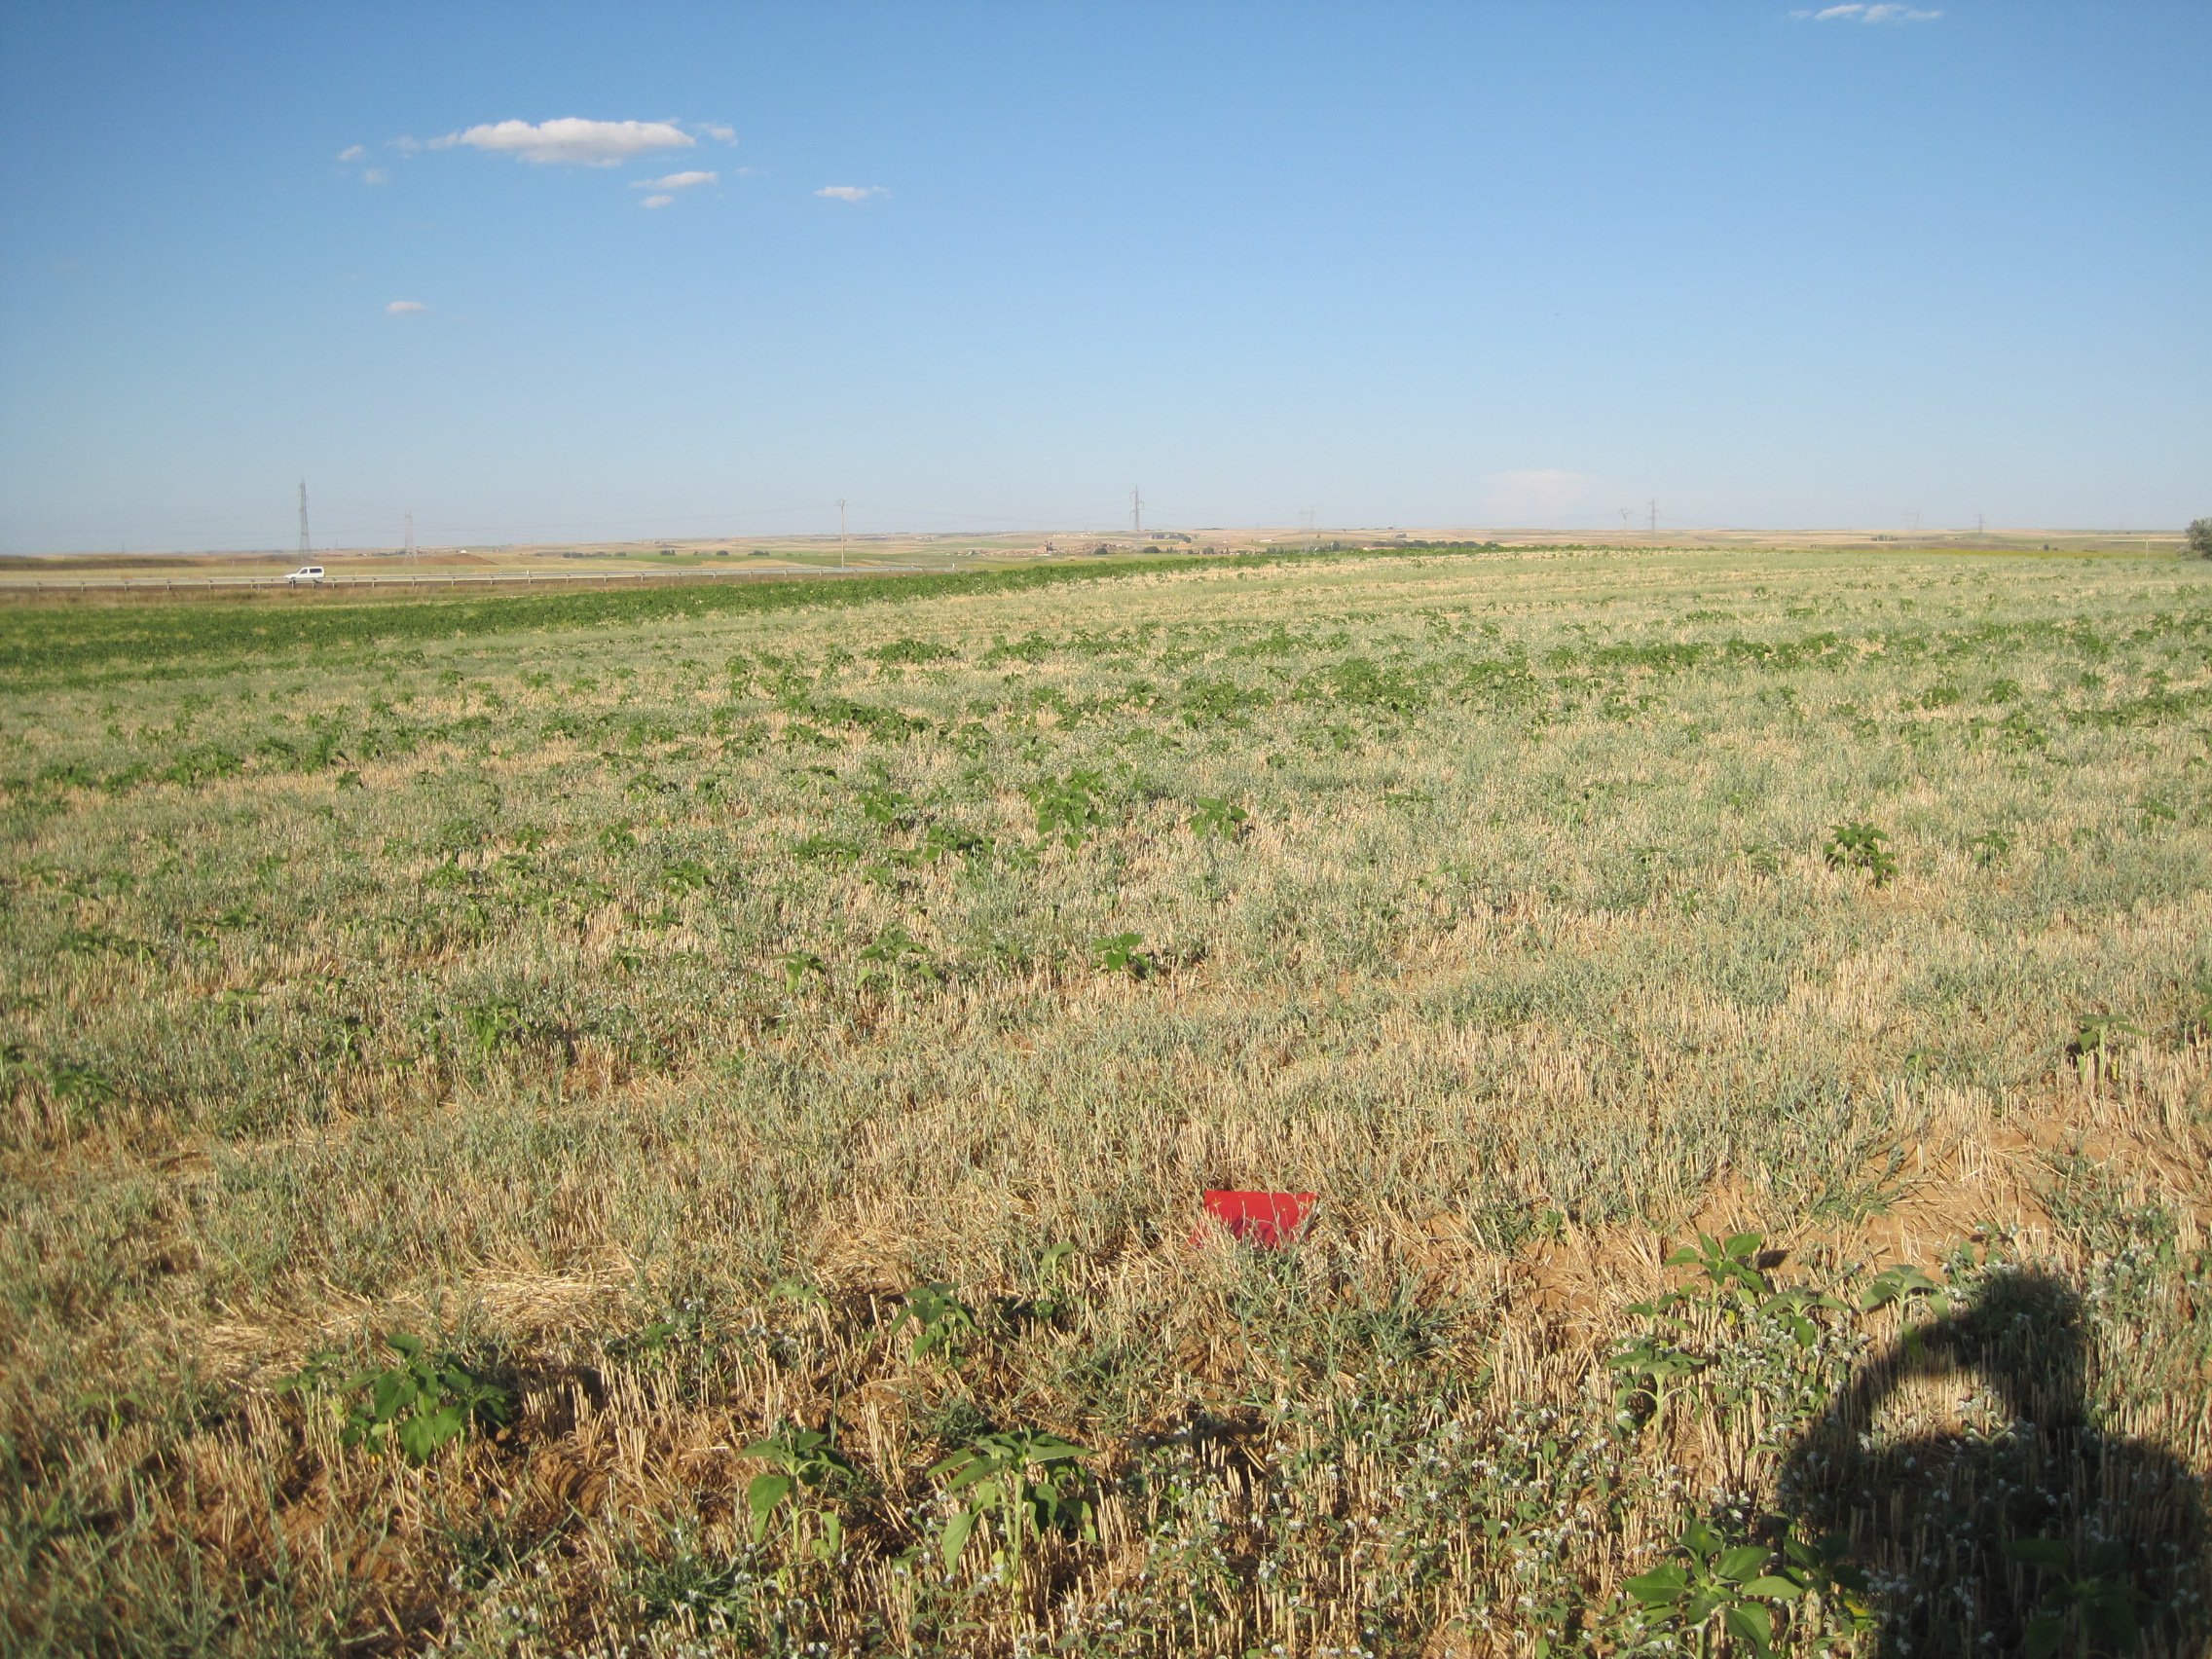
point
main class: Cropland
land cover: Barley
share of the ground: < 10 %
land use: Agriculture (excluding fallow land and kitchen gardens)
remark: Harvested field
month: July
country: ES
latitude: 42.1168
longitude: -5.2394
